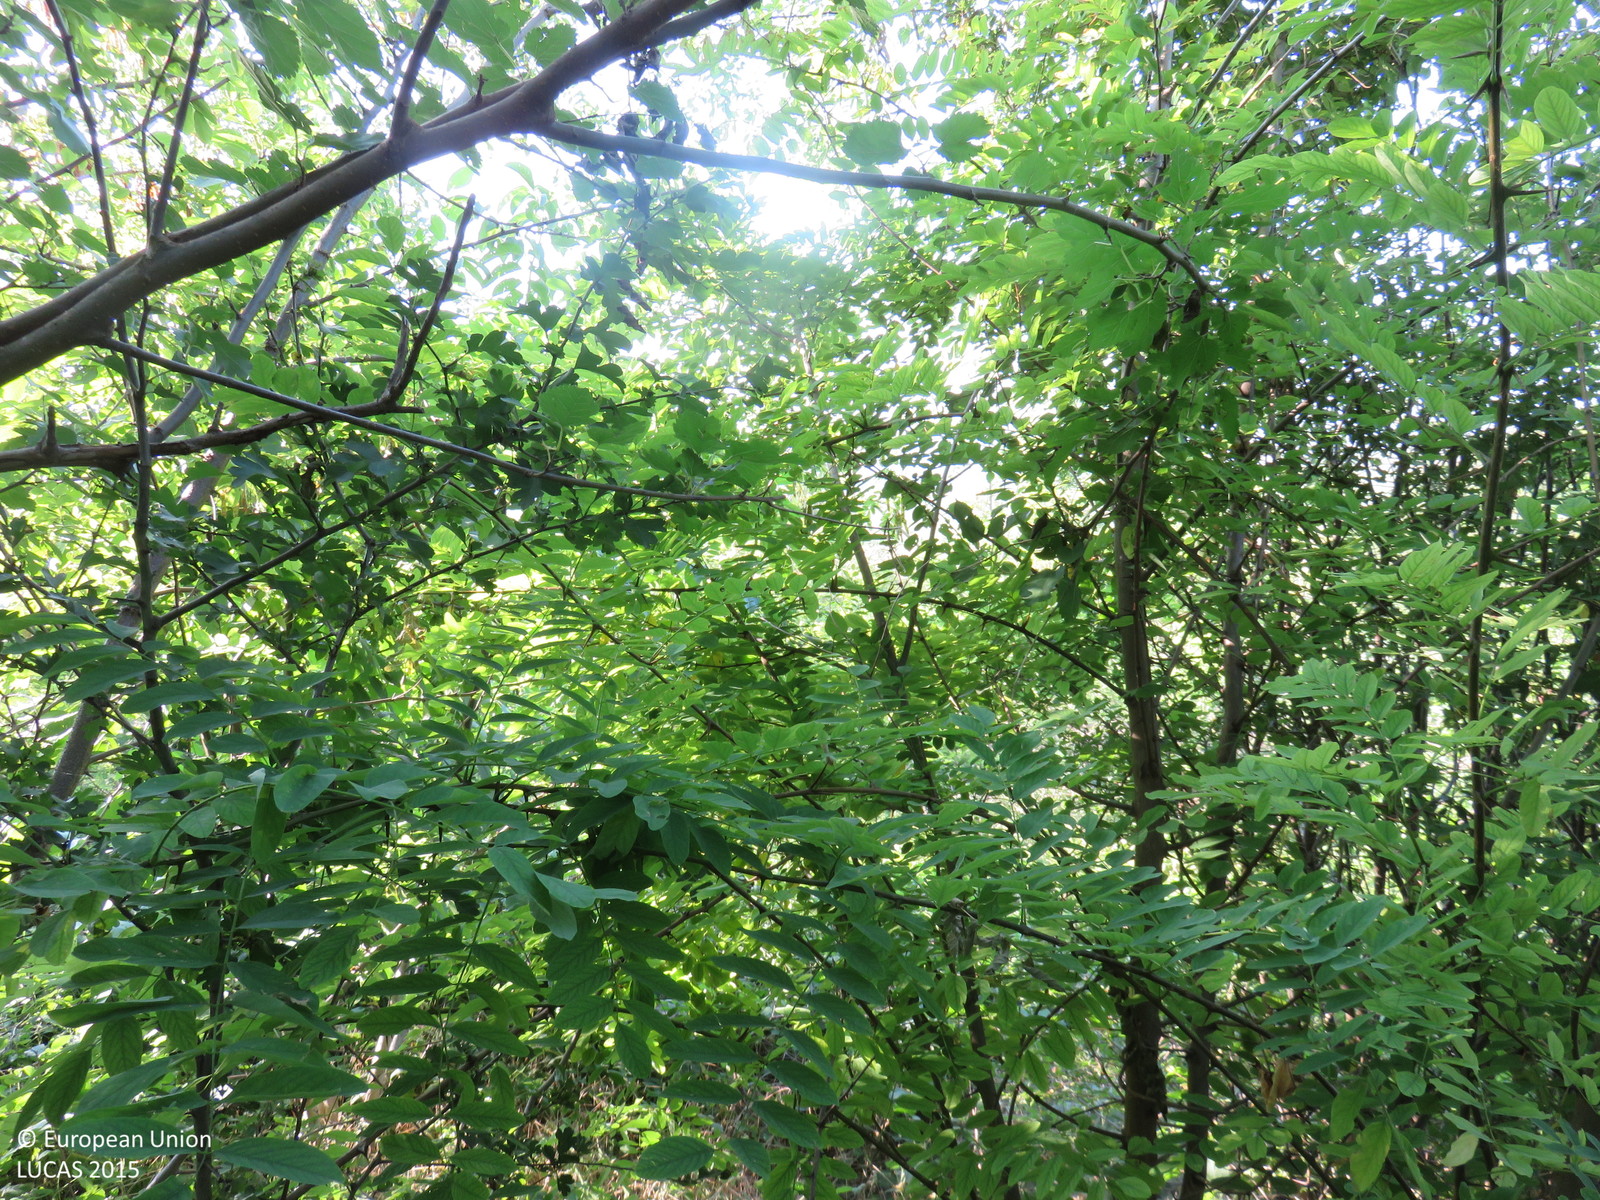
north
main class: Woodland
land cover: Broadleaved woodland
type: mesophytic deciduous forest
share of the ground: > 75 %
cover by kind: broadleaved forest trees 90 %, shrubs 5 %, herbaceous plants 5 %
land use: Forestry
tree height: < 5 m
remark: Clear cut
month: July
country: BG
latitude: 43.4880
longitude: 25.0208
